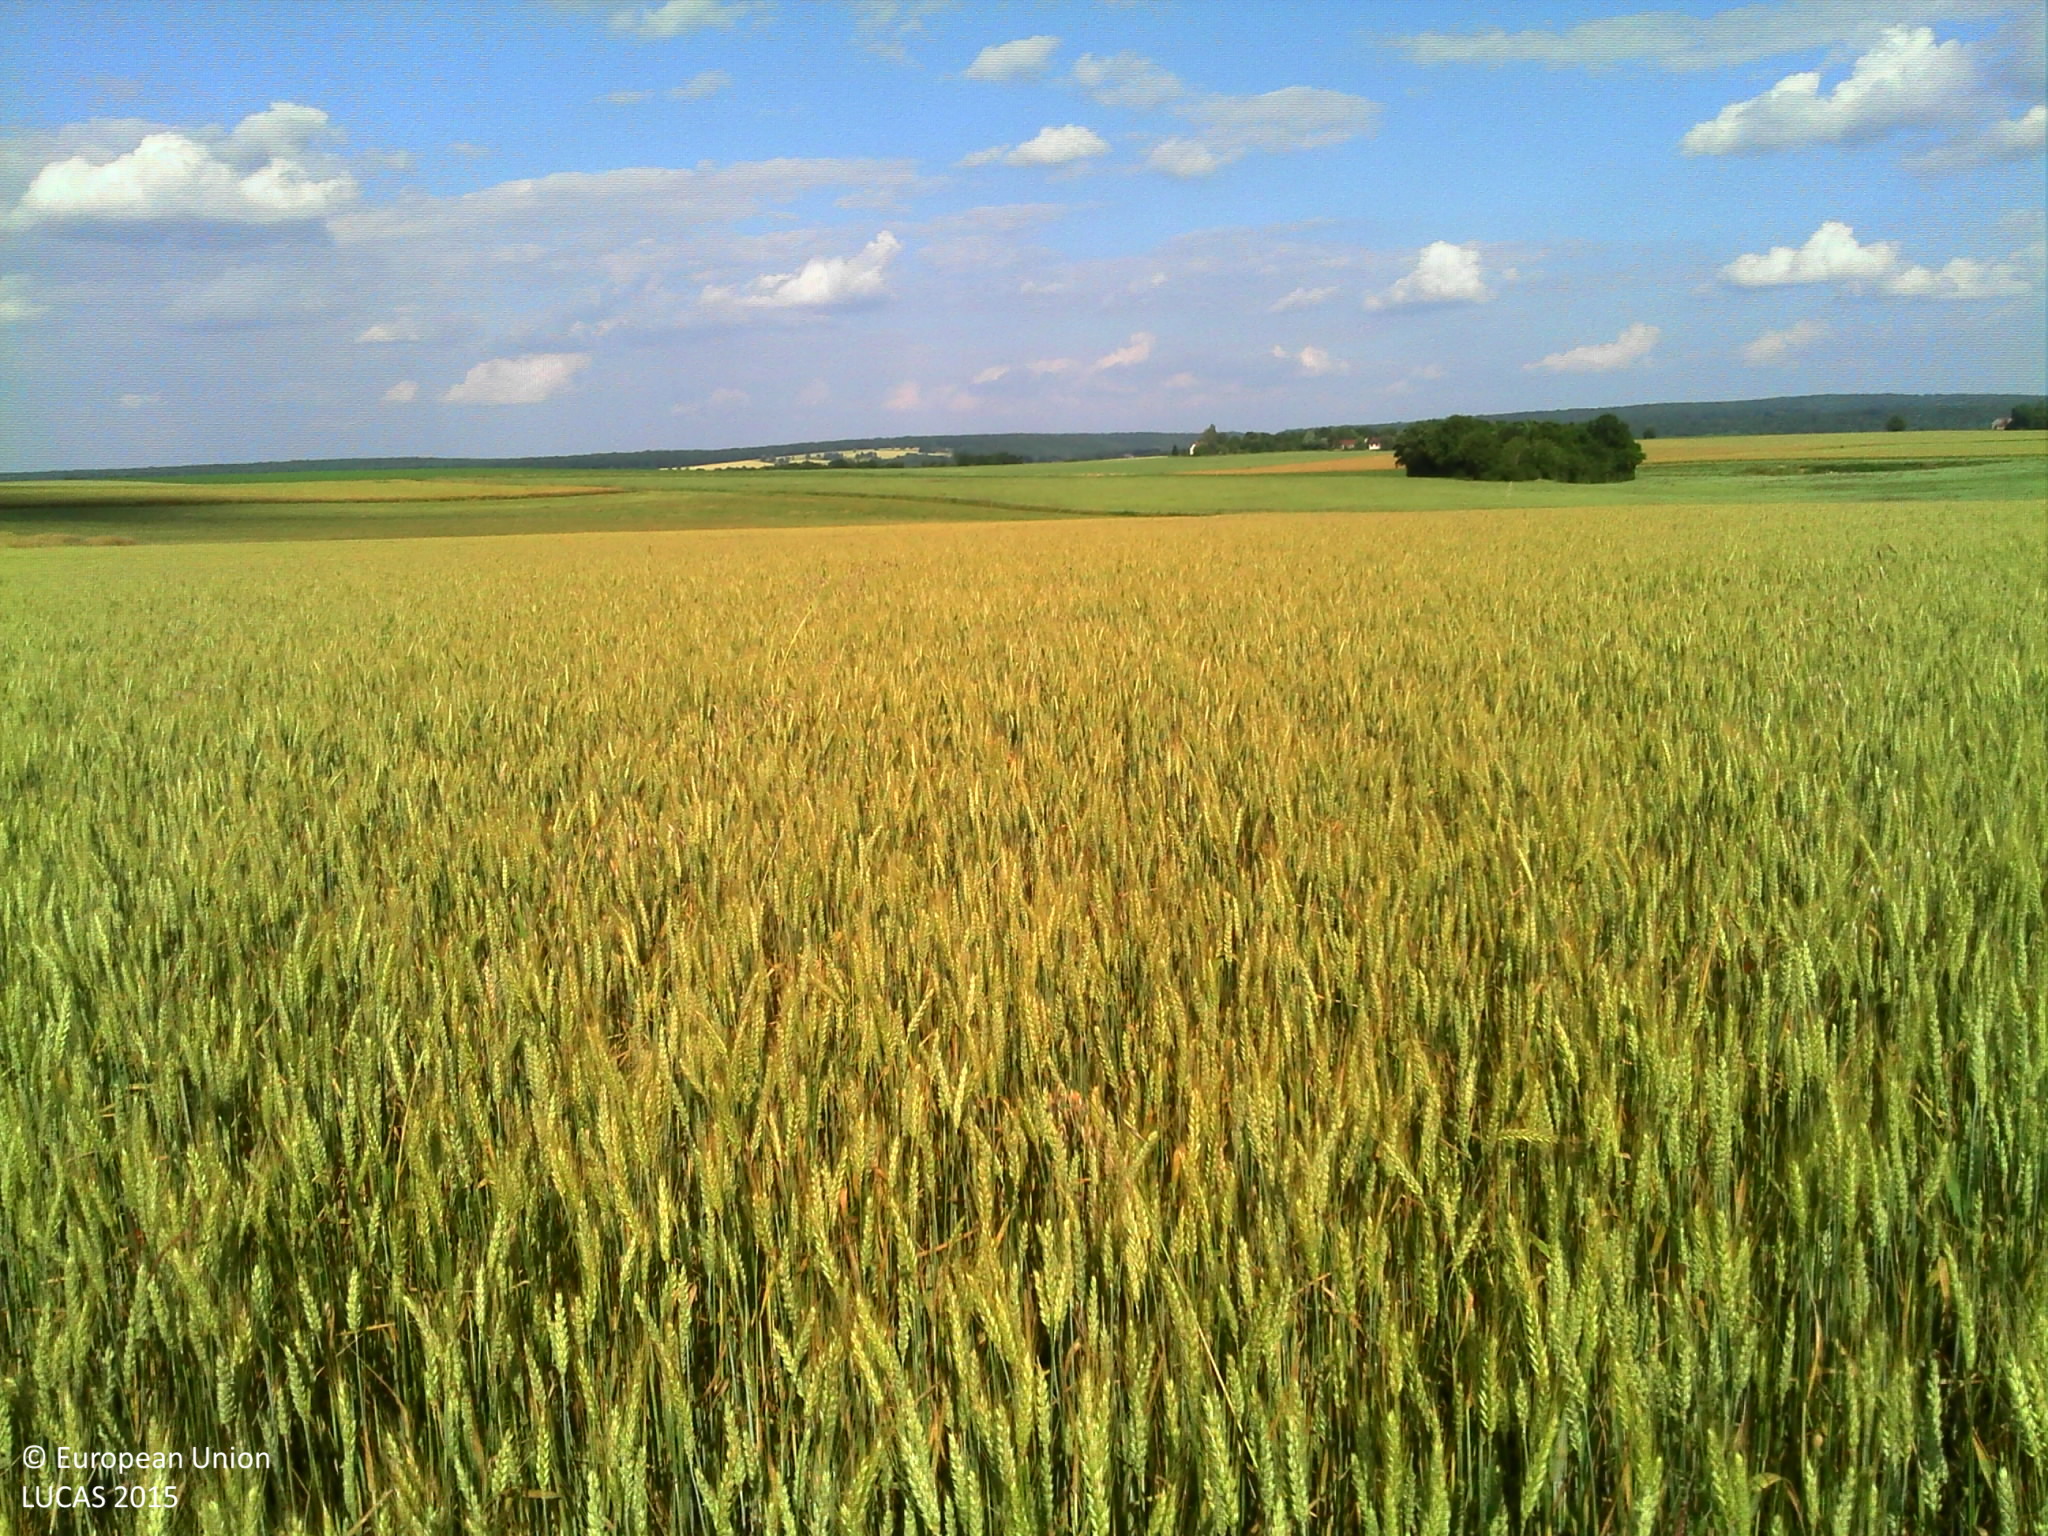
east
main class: Cropland
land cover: Common wheat
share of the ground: > 75 %
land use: Agriculture (excluding fallow land and kitchen gardens)
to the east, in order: Common wheat
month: June
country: FR
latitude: 47.4173
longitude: 3.1957
